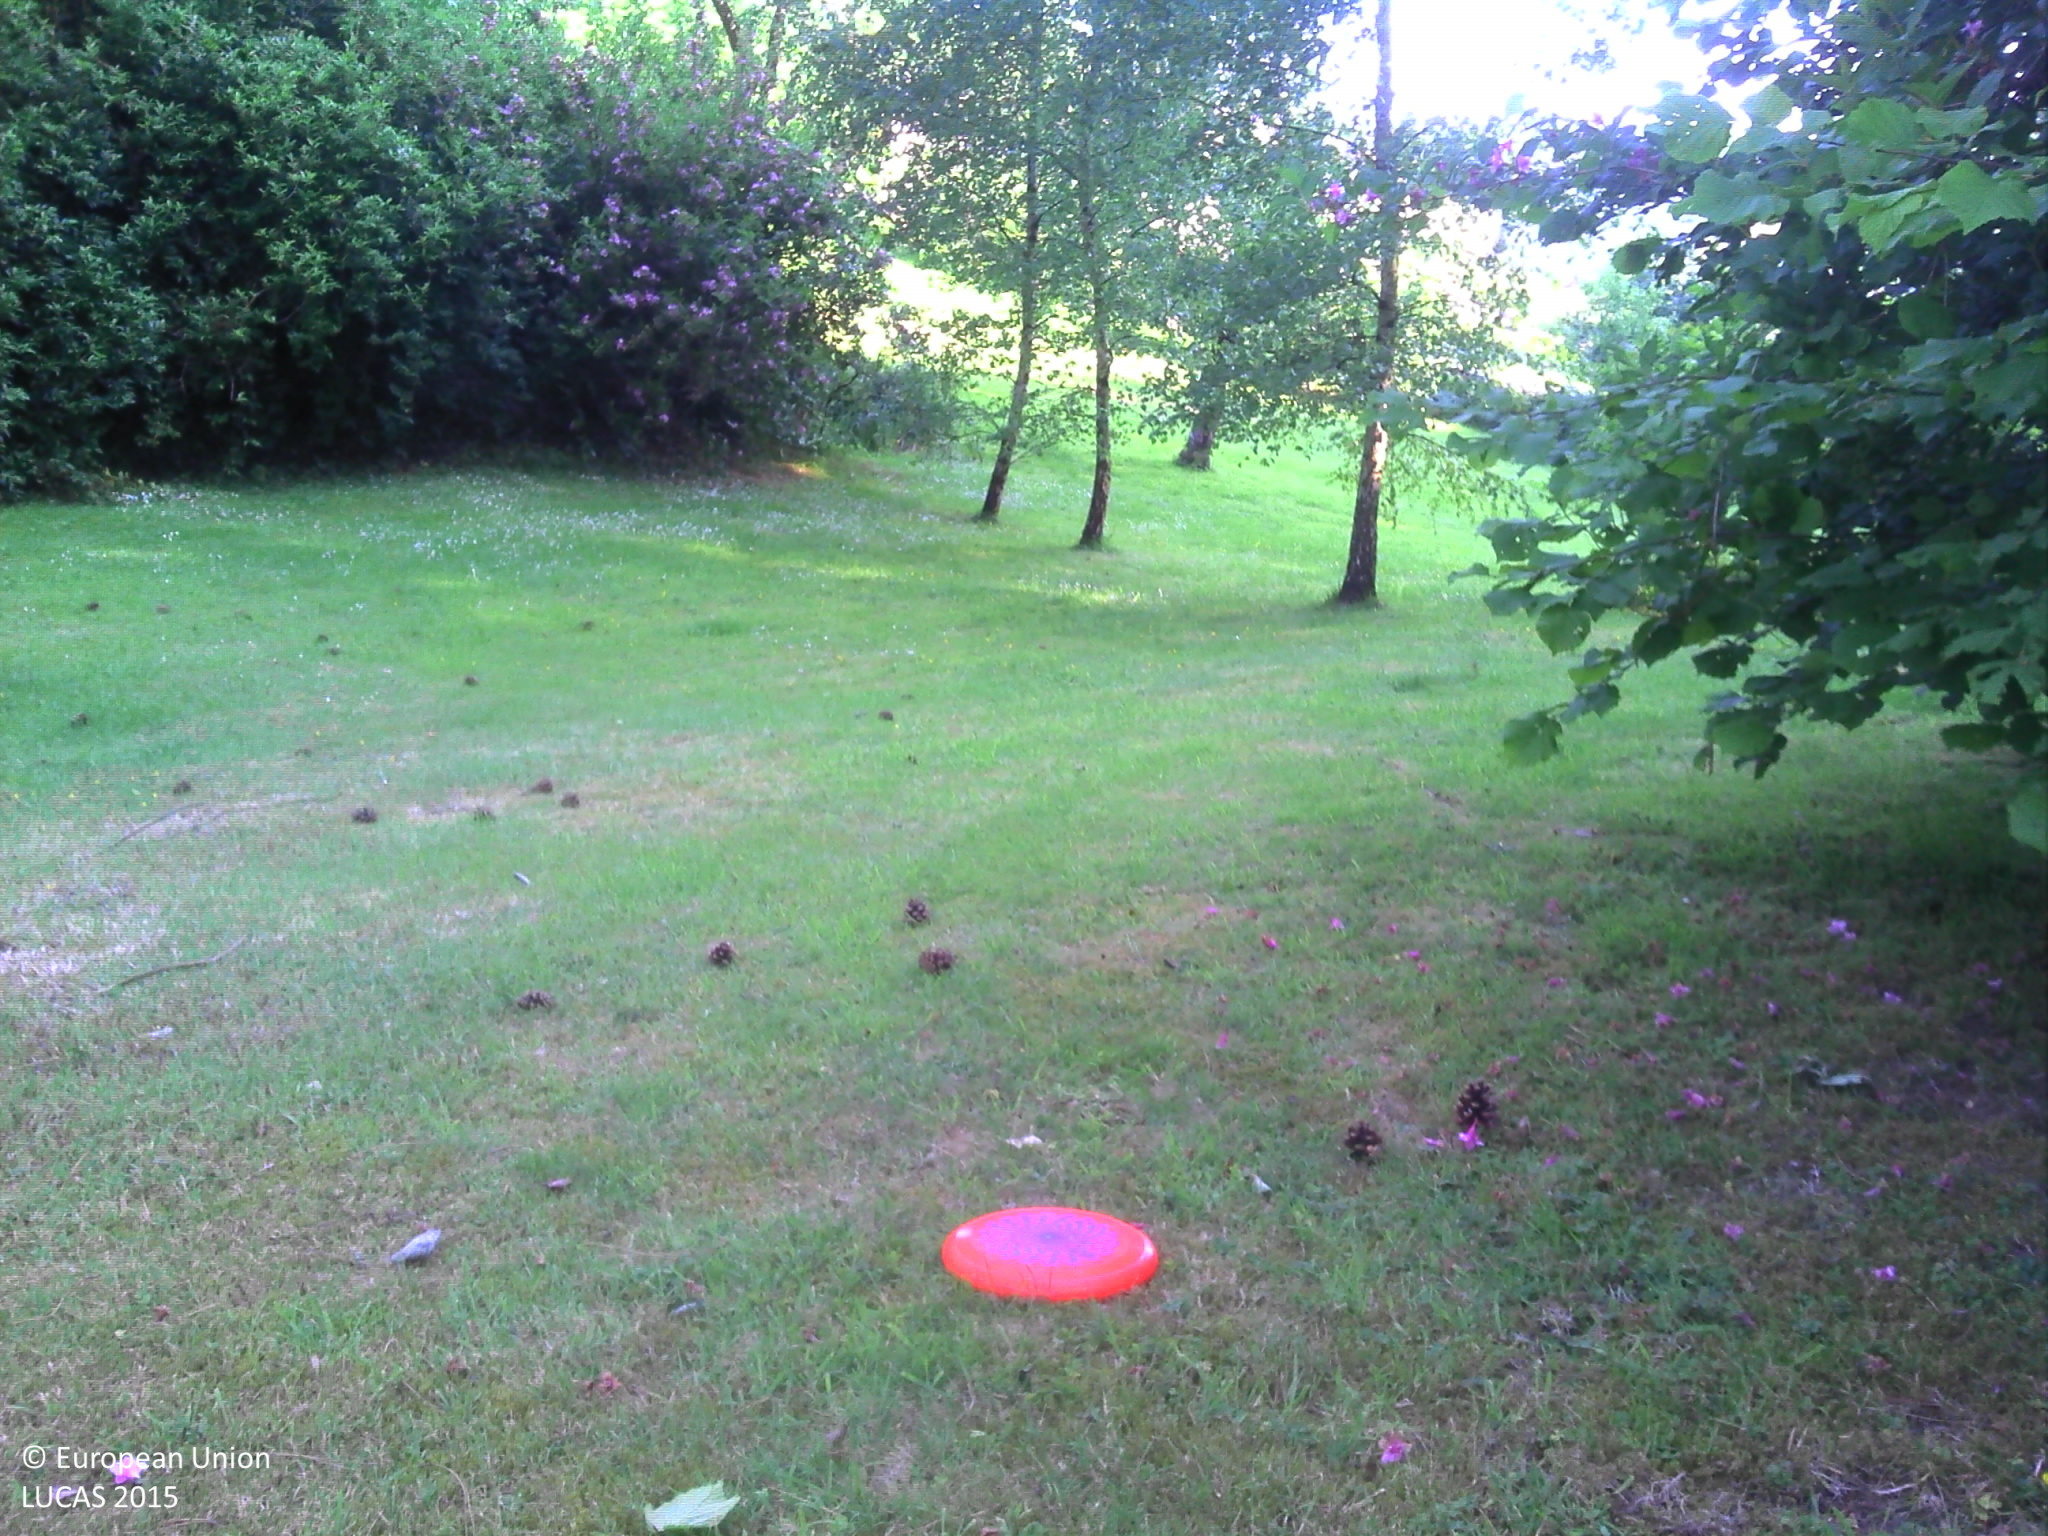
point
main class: Woodland
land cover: Broadleaved woodland
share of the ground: 50 - 75 %
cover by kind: broadleaved forest trees 60 %, herbaceous plants 25 %, coniferous forest trees 15 %
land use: Residential
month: June
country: BE
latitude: 50.0532
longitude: 4.5351
